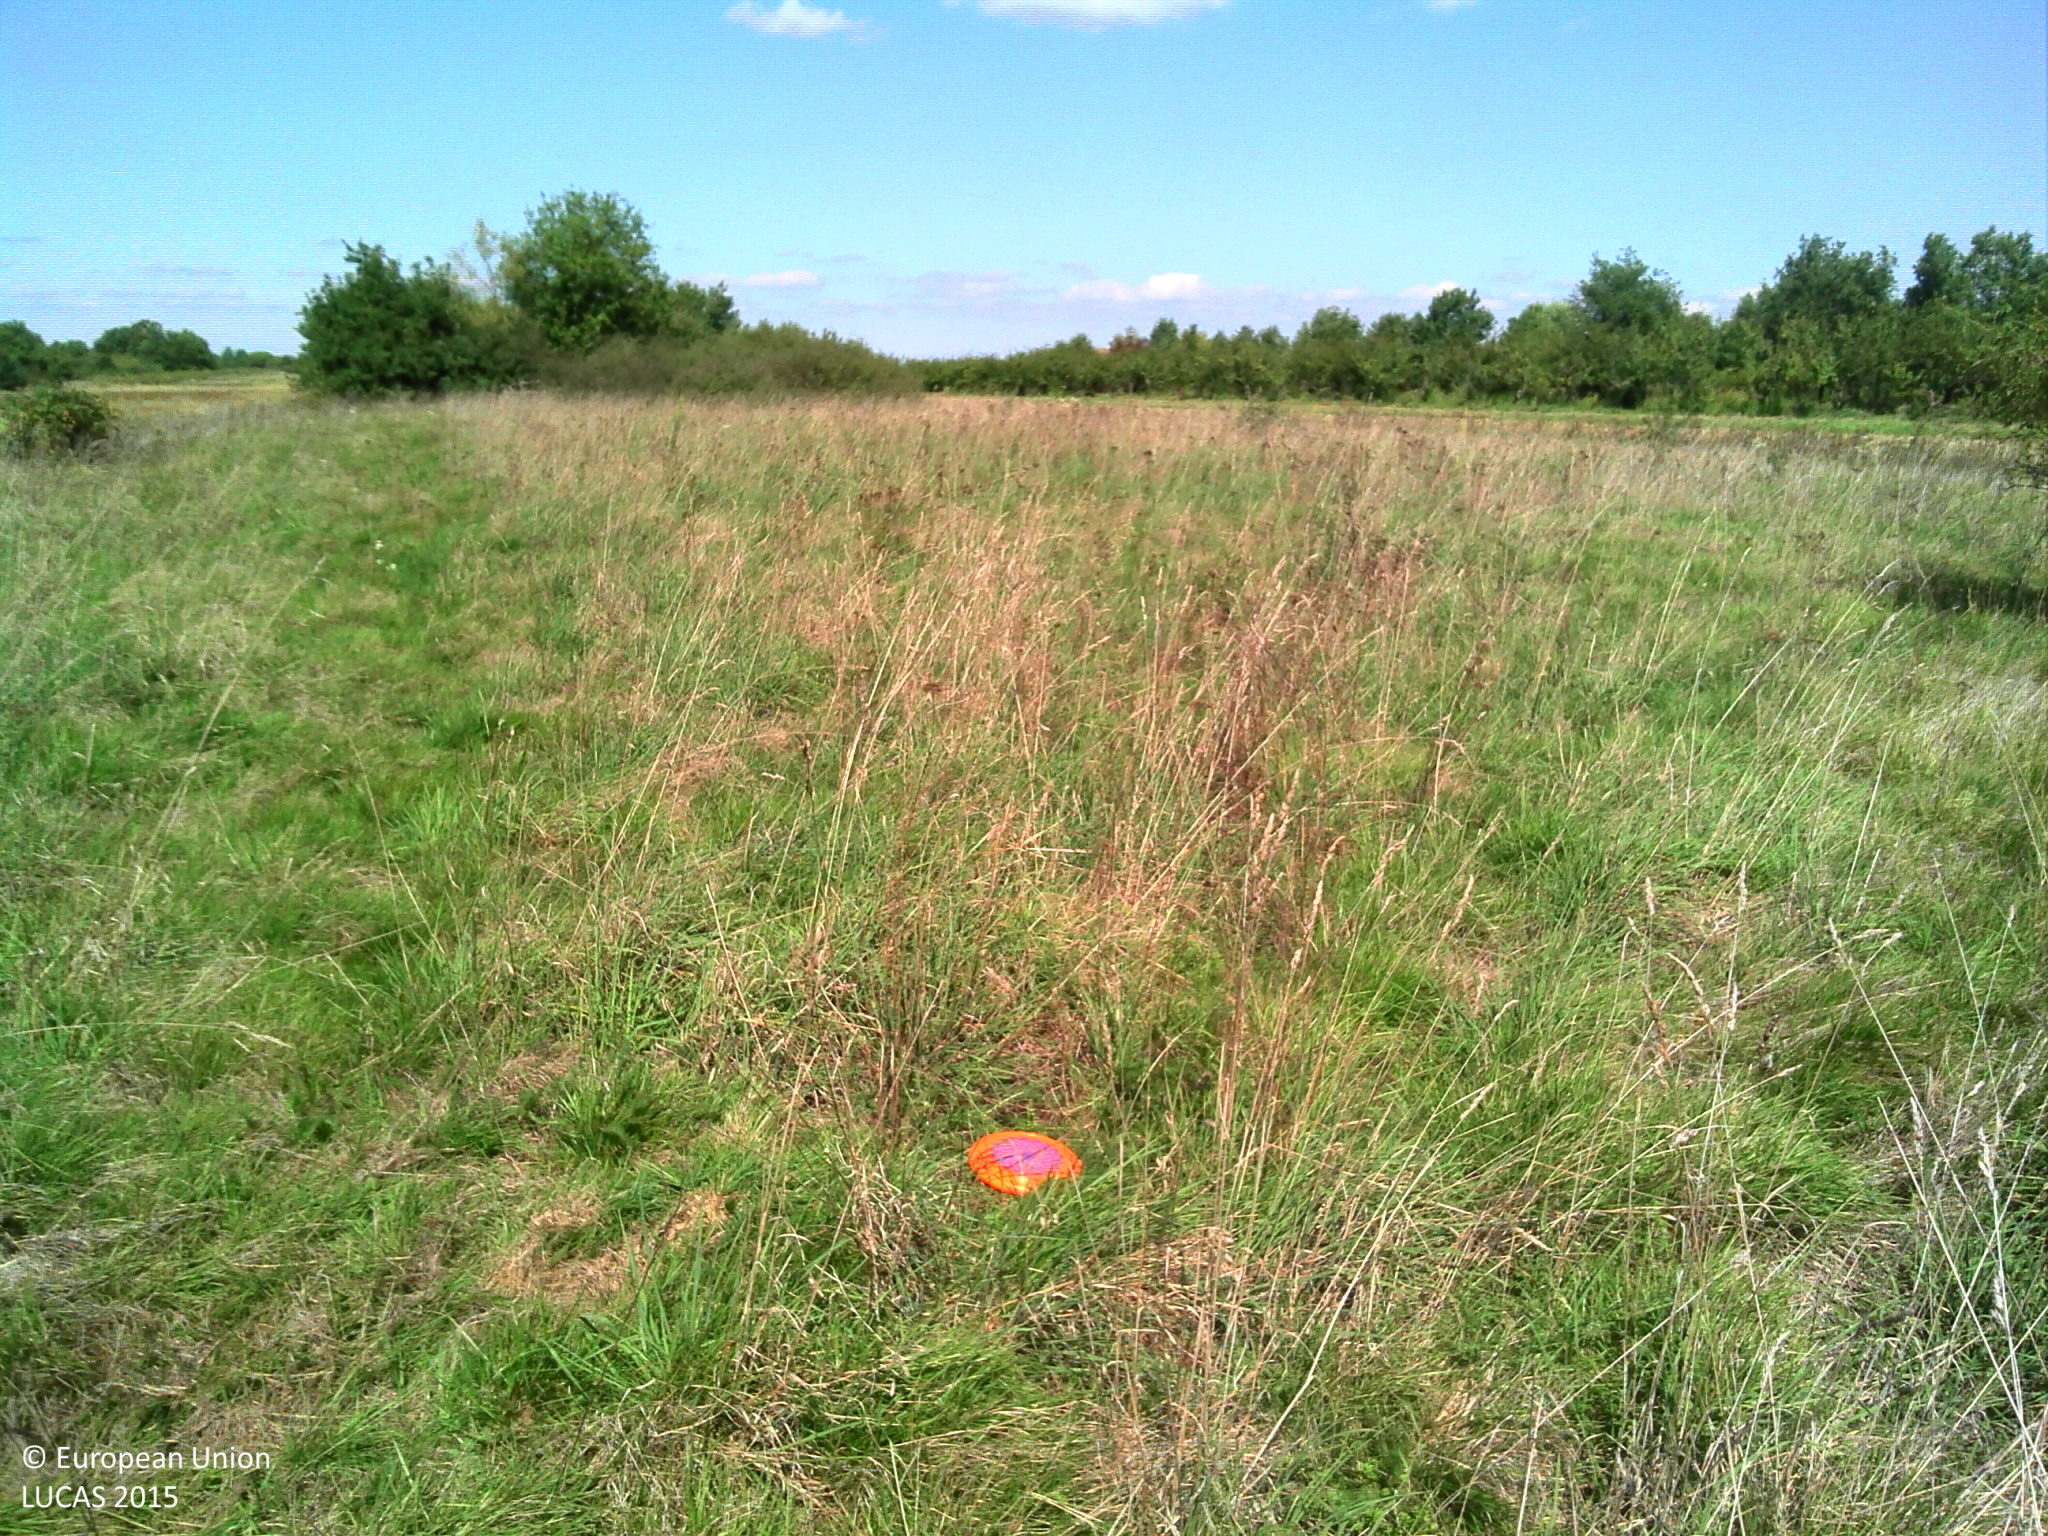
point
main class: Grassland
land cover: Grassland without tree/shrub cover
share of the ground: > 75 %
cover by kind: herbaceous plants 100 %
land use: Agriculture (excluding fallow land and kitchen gardens)
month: September
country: FR
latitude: 43.8738
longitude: 1.2767
